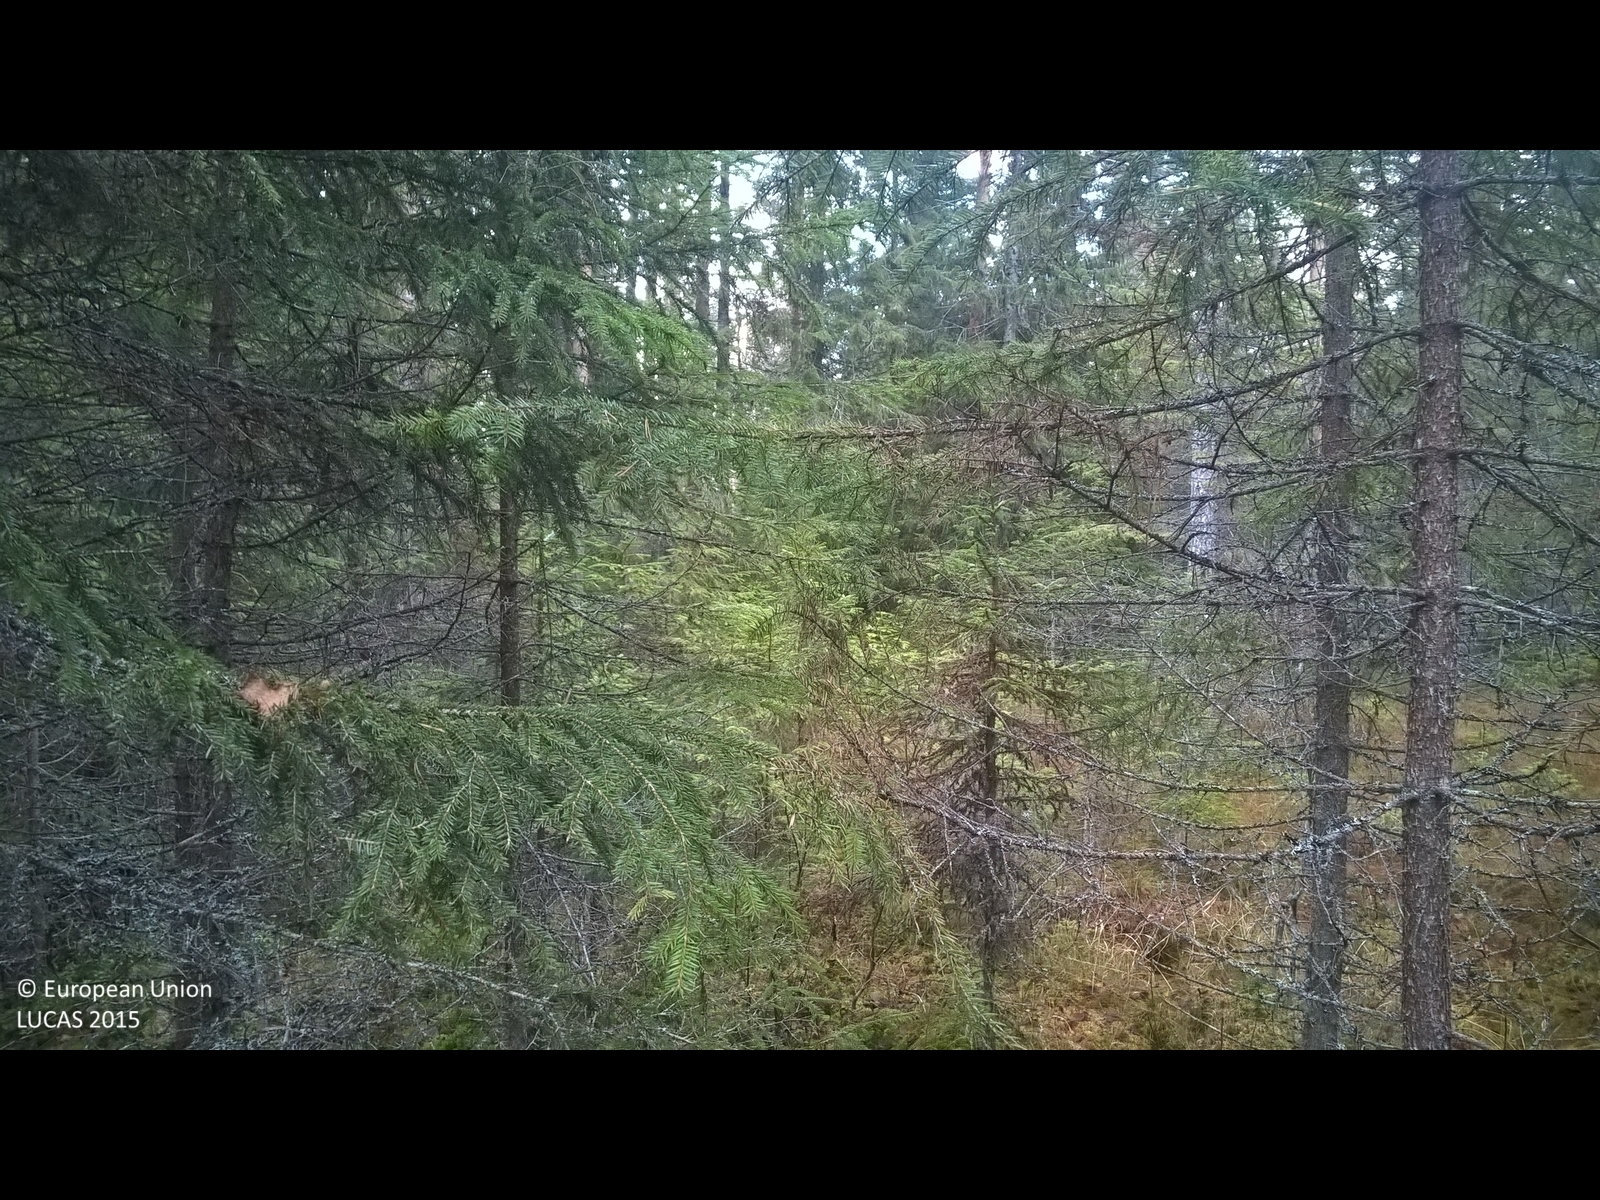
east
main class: Woodland
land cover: Spruce dominated coniferous woodland
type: boreal forest
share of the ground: > 75 %
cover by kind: coniferous forest trees 75 %, lichens and mosses 15 %, broadleaved forest trees 10 %
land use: Forestry
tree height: > 5 m
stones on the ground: < 10 %
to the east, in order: Spruce dominated coniferous woodland; Ditches and canals; Other mixed woodland; Ditches and canals; Spruce dominated mixed woodland; Pine dominated coniferous woodland
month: November
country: SE
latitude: 62.7471
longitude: 14.9711
